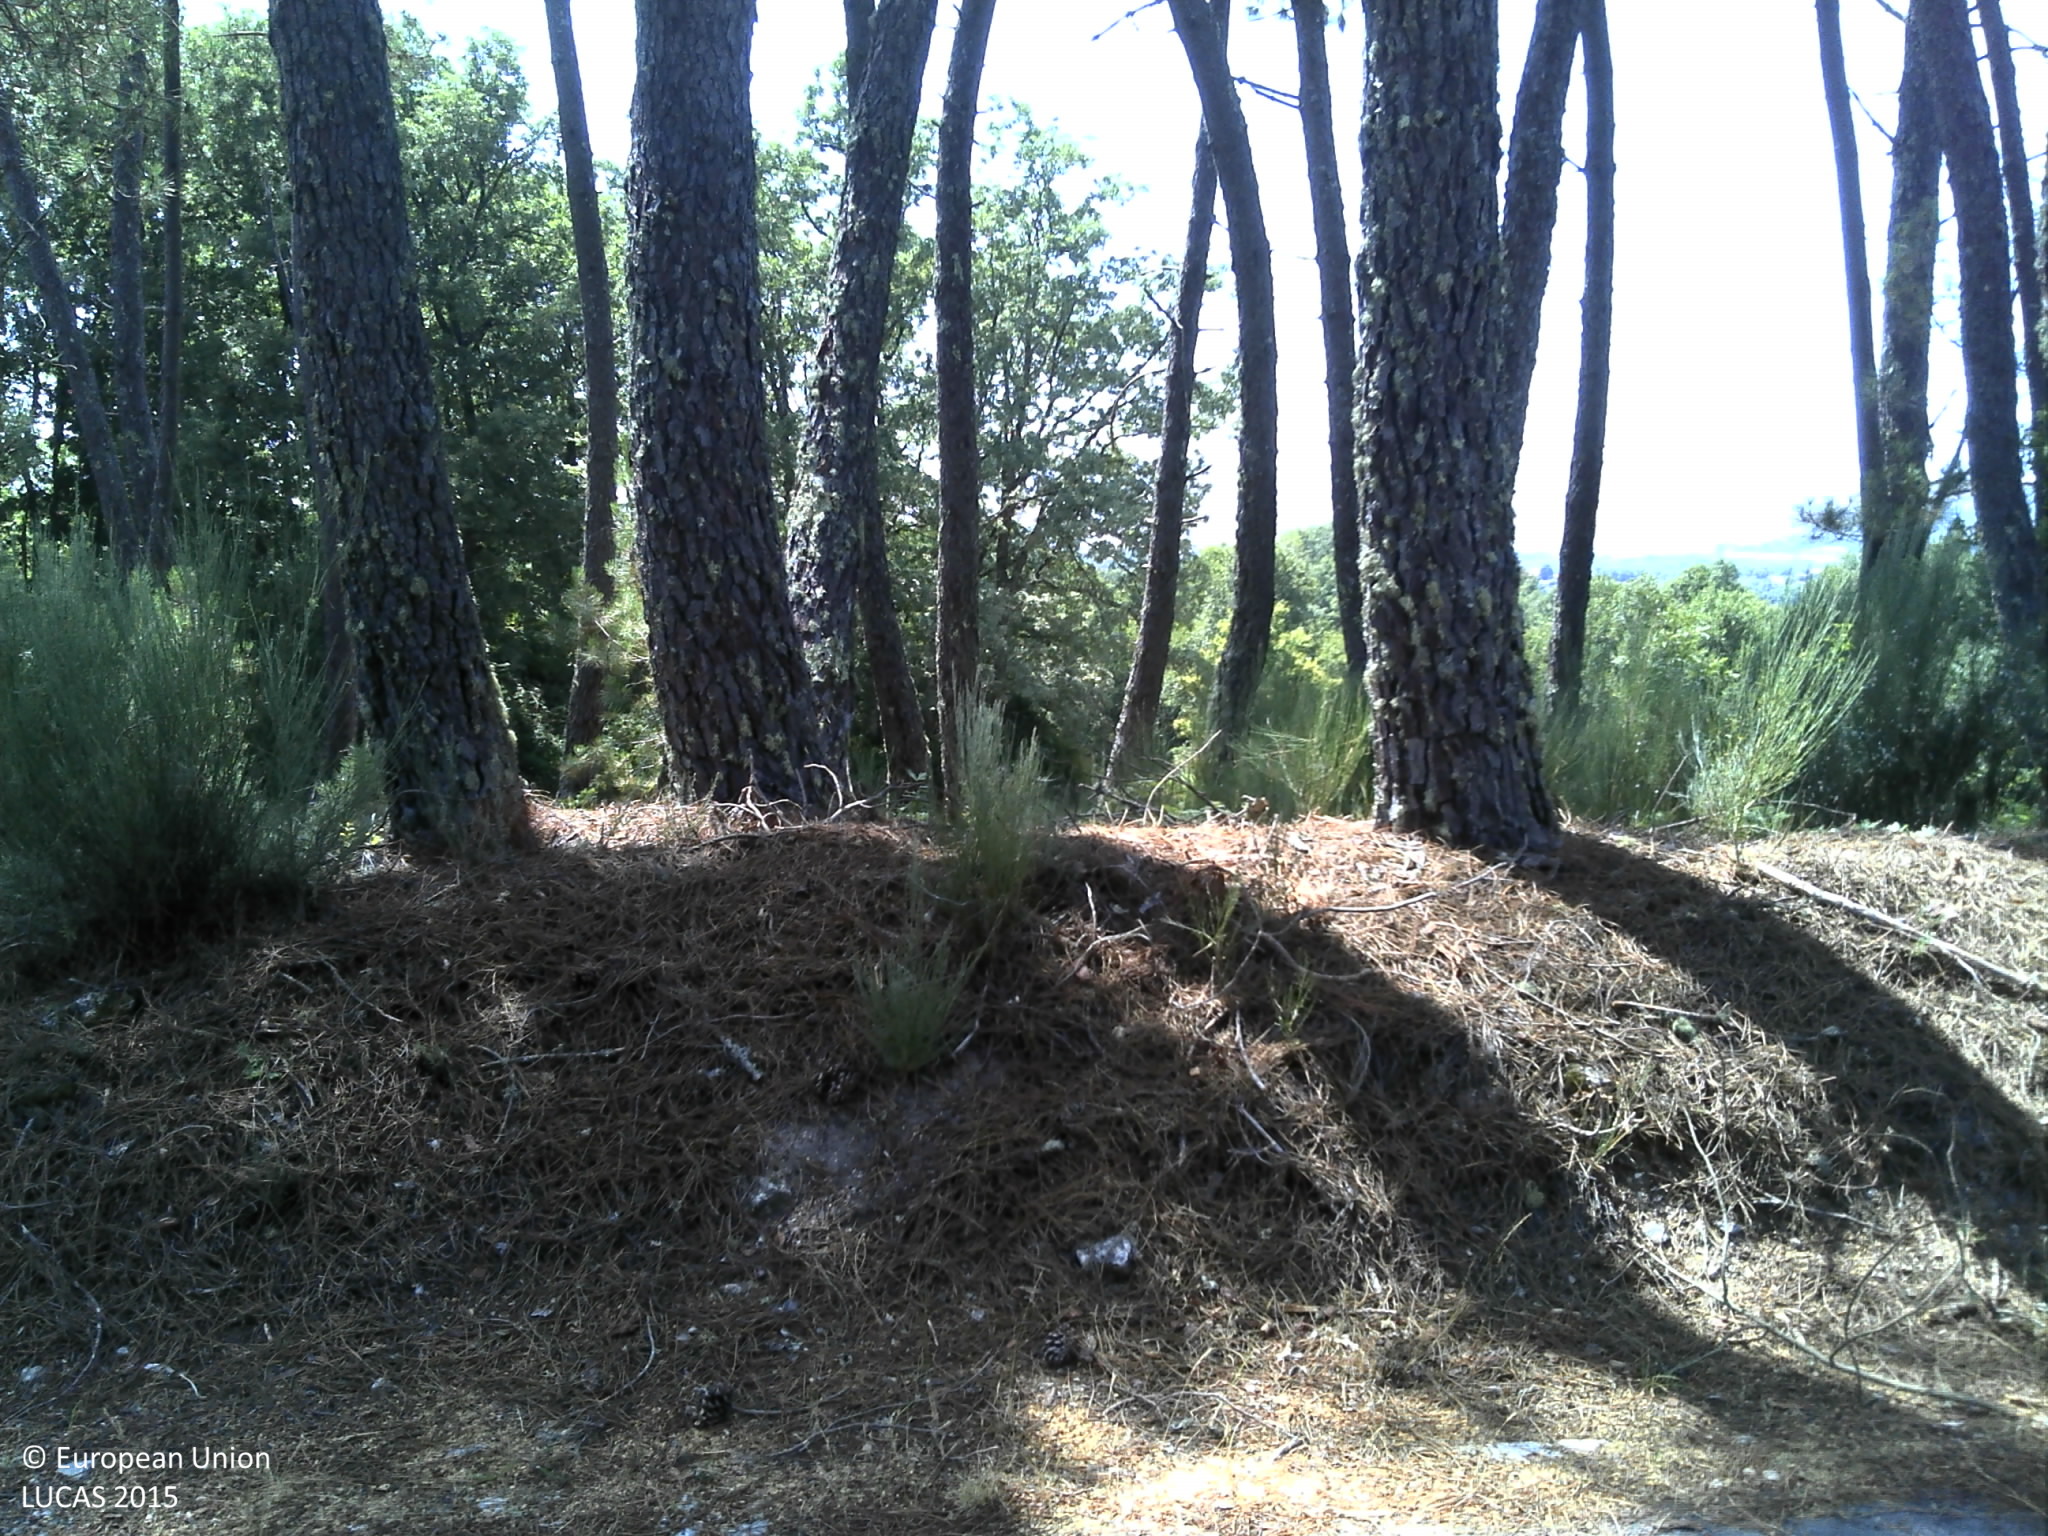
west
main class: Shrubland
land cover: Shrubland with sparse tree cover
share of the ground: > 75 %
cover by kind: shrubs 70 %, unconsolidated bare surface 25 %, coniferous forest trees 5 %
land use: Semi-natural and natural areas not in use
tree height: > 5 m
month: July
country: PT
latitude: 40.9579
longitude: -7.8664
